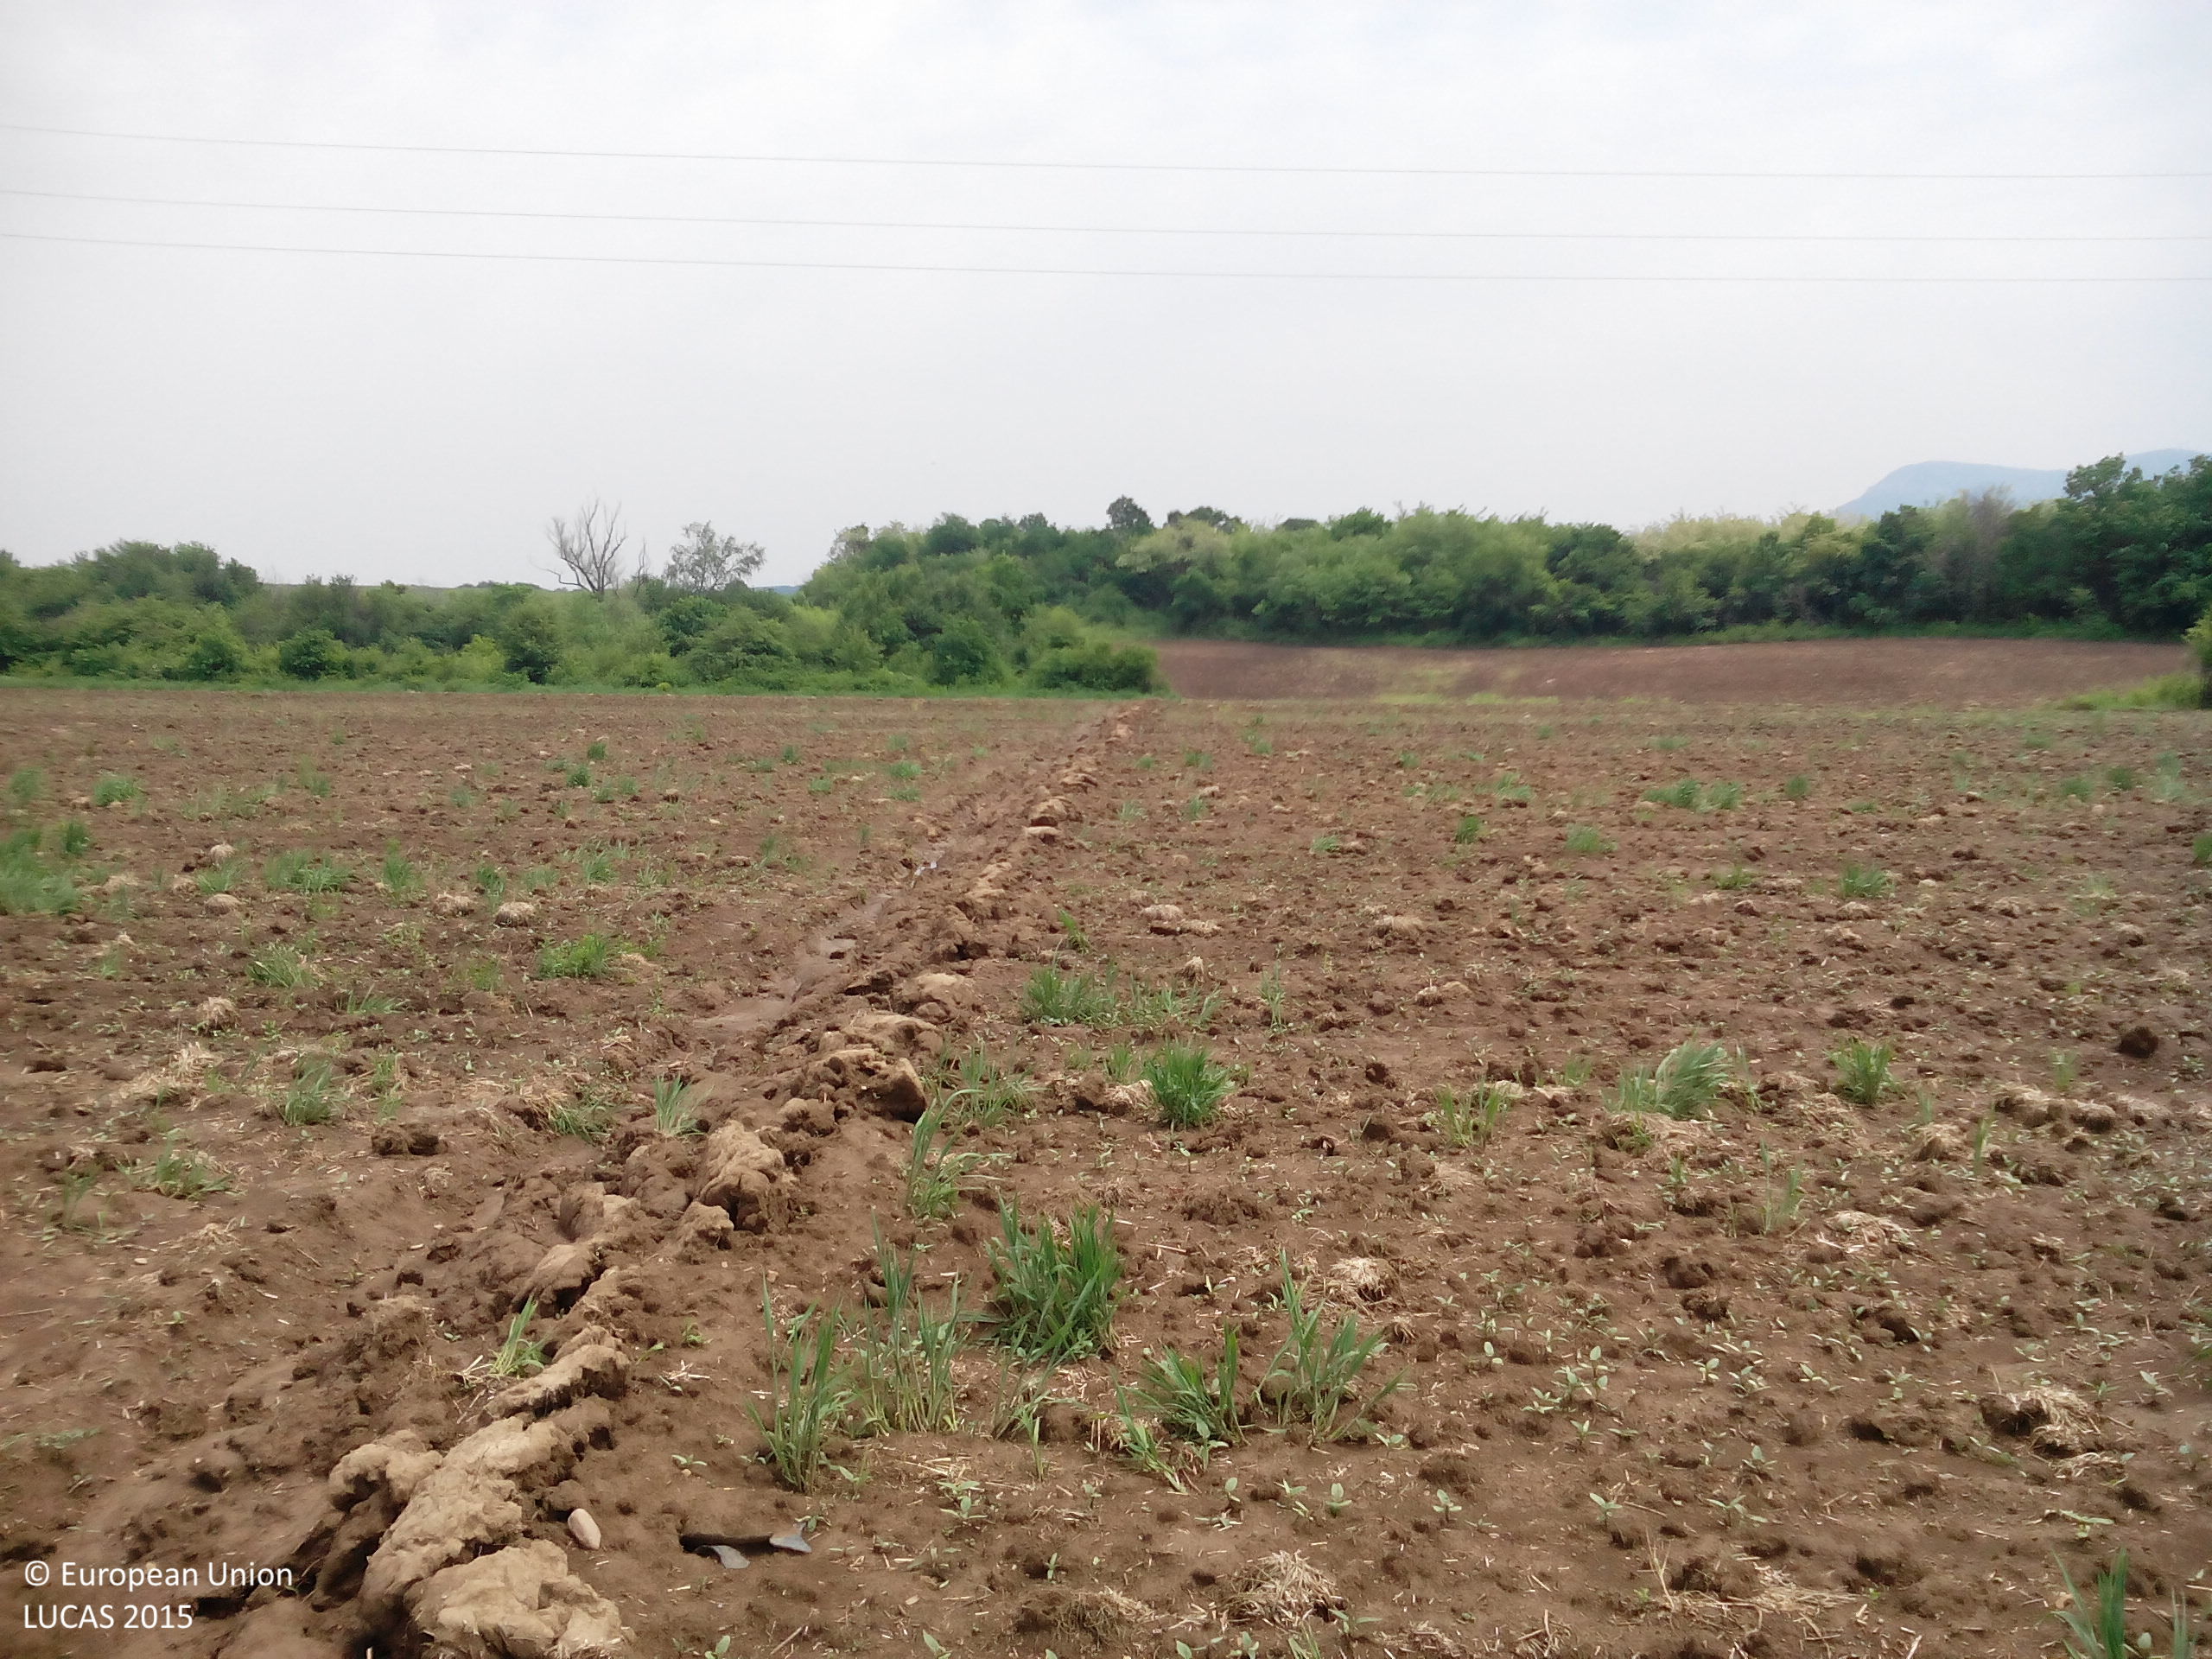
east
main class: Cropland
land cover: Sunflower
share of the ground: < 10 %
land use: Agriculture (excluding fallow land and kitchen gardens)
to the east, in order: Sunflower; Electric lines; Sunflower; Shrubland without tree cover; Broadleaved woodland; Shrubland without tree cover
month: May
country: BG
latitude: 43.2763
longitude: 23.5358
